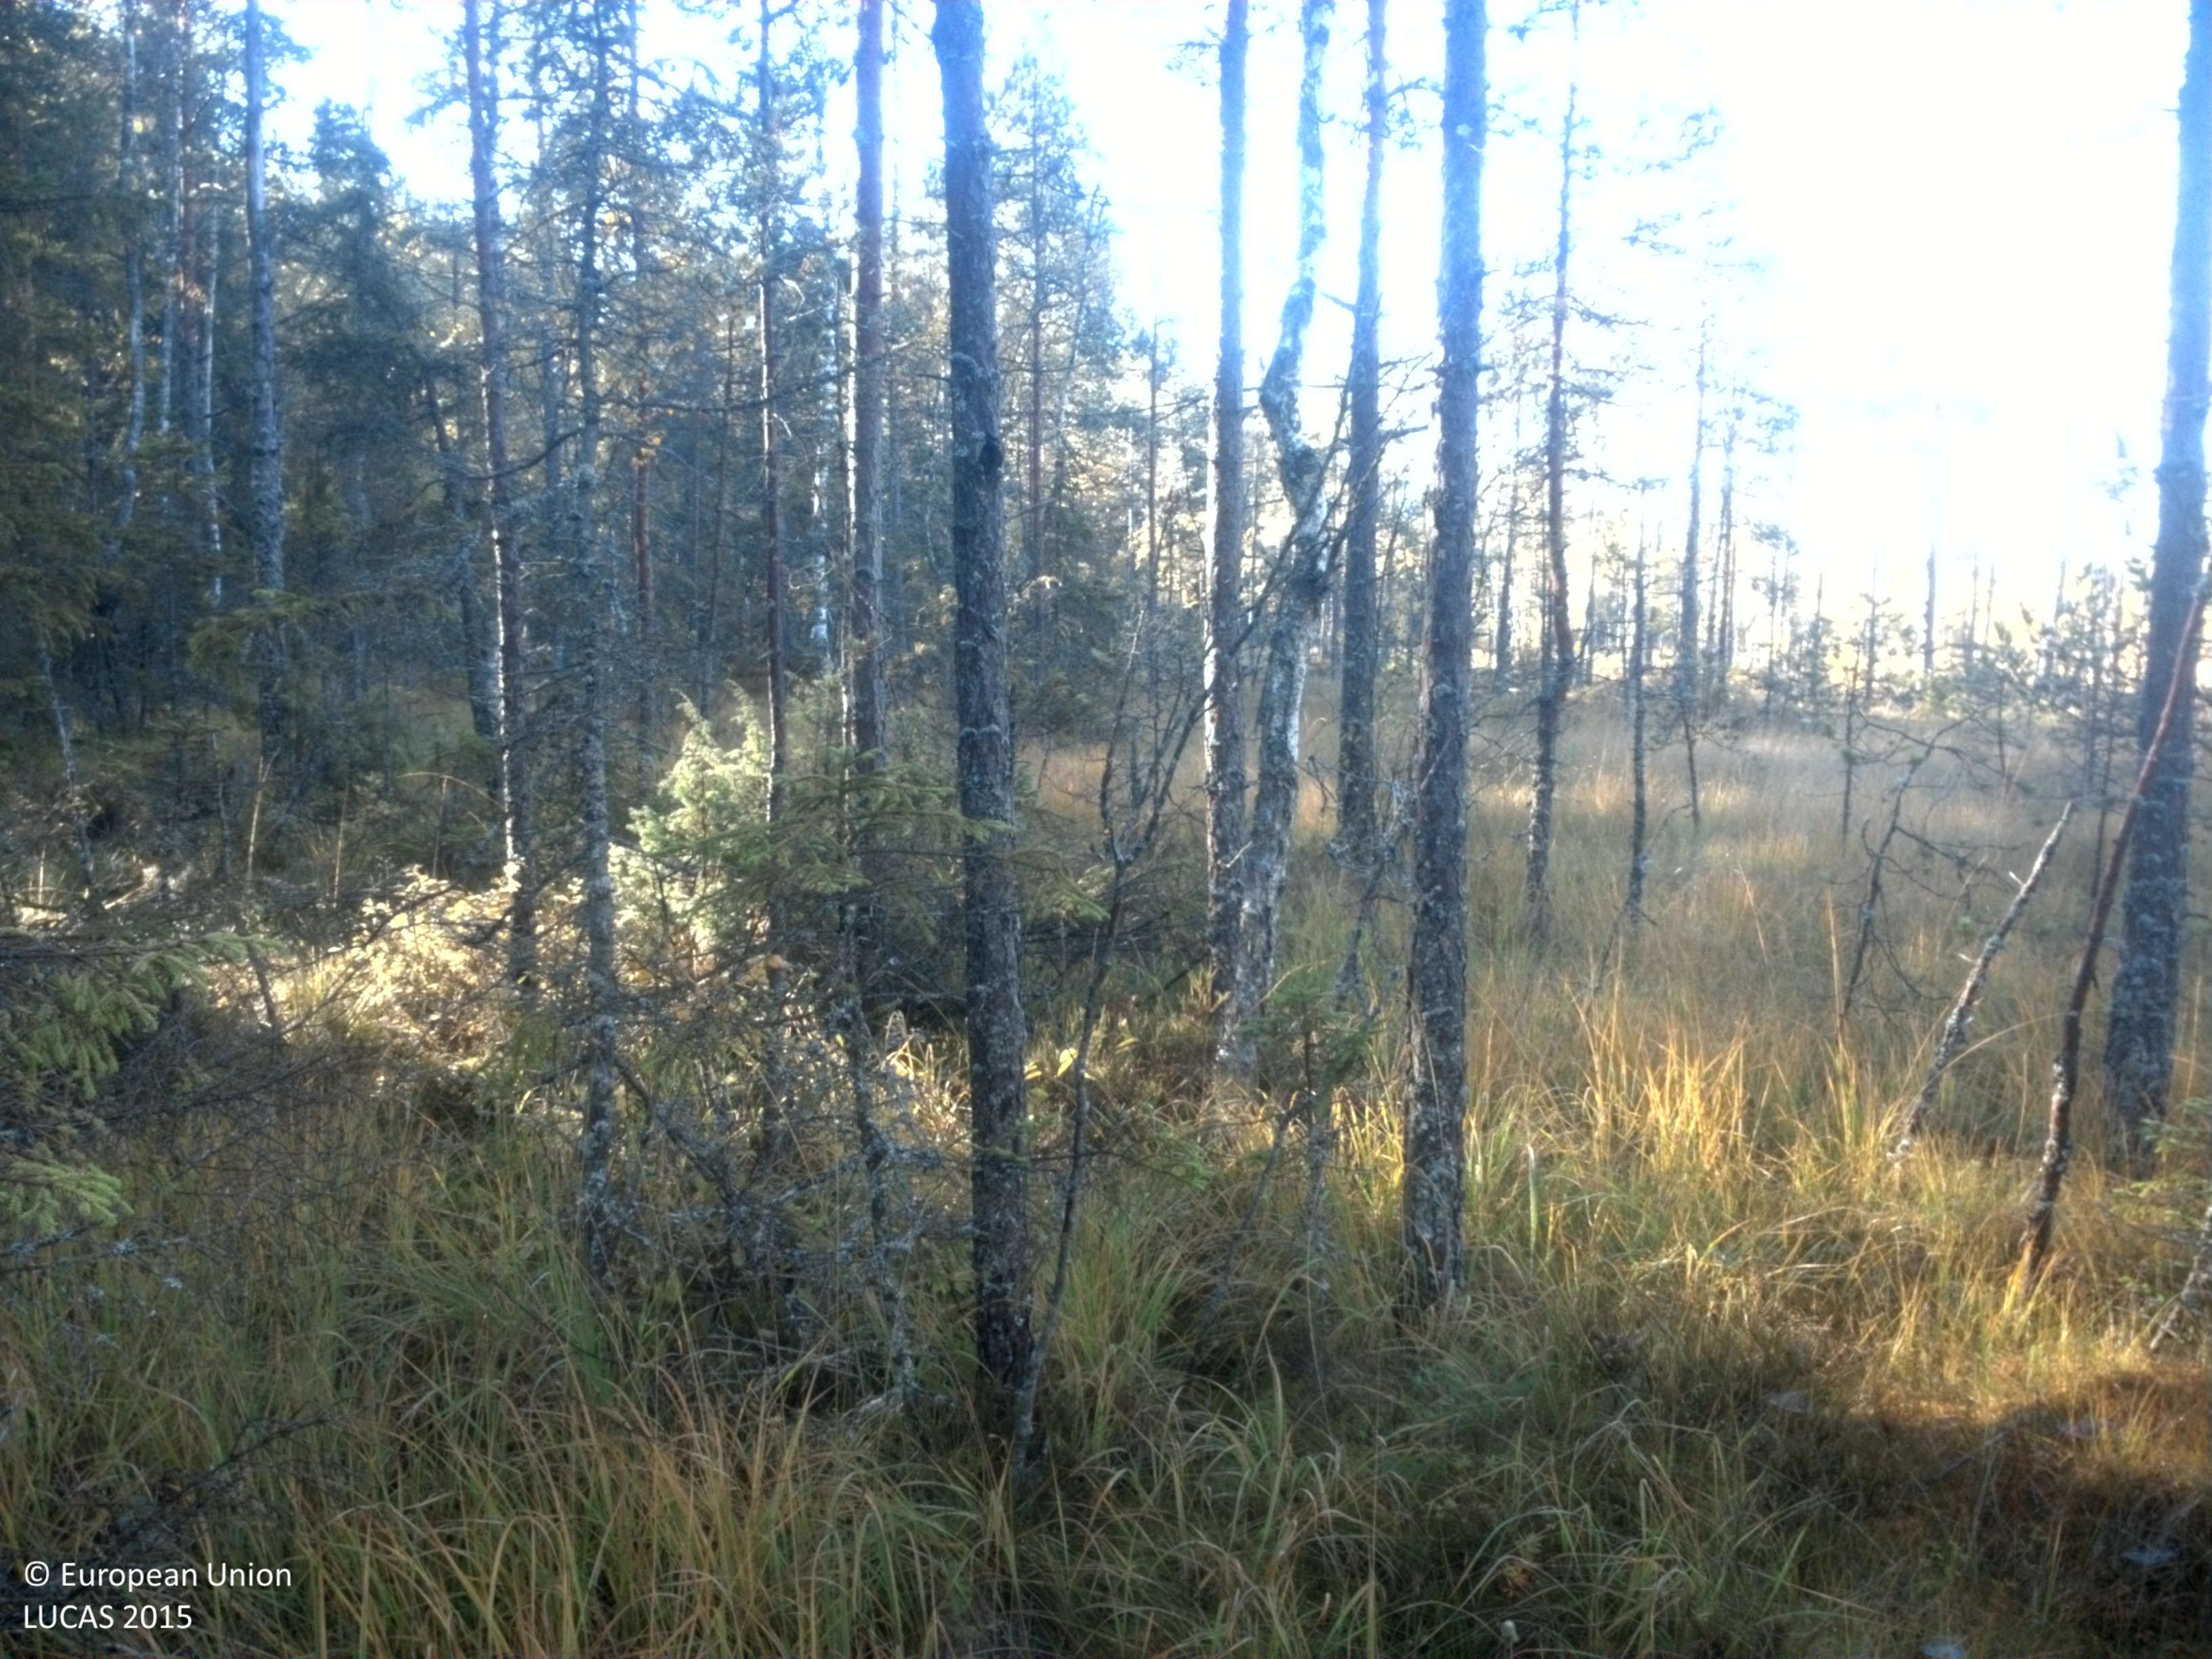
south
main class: Woodland
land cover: Other mixed woodland
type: mire and swamp forests
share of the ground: 50 - 75 %
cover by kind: coniferous forest trees 45 %, broadleaved forest trees 15 %, herbaceous plants 15 %, lichens and mosses 15 %, shrubs 10 %
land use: Forestry
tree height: > 5 m
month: September
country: SE
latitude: 59.9047
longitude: 15.1924
